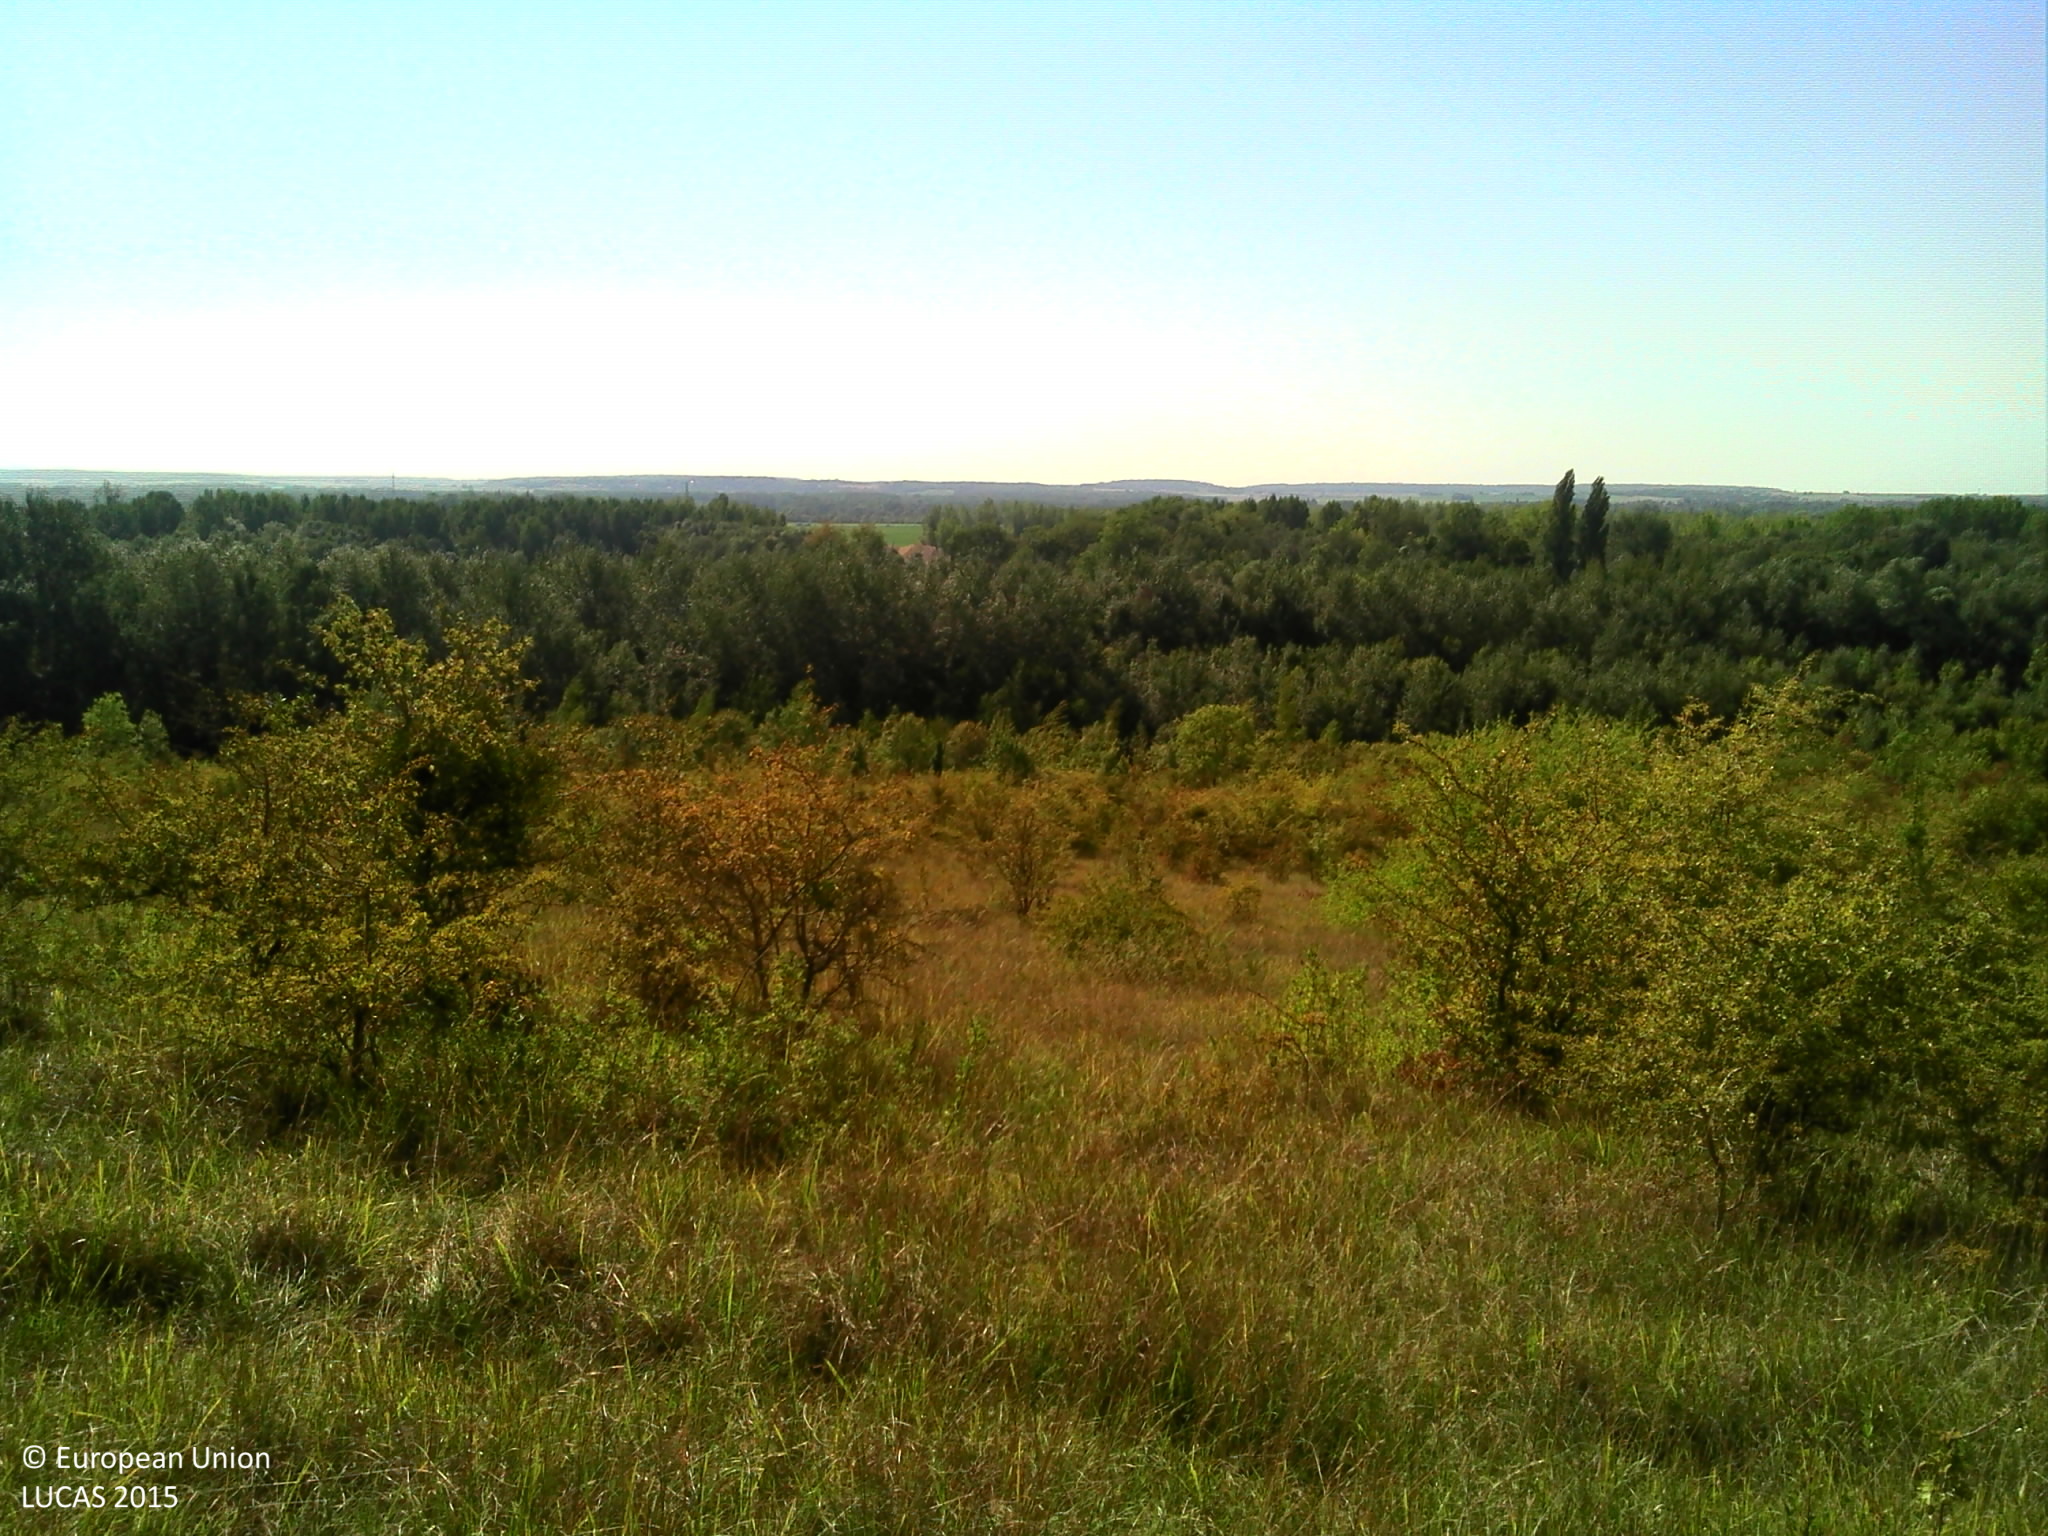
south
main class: Shrubland
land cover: Shrubland with sparse tree cover
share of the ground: > 75 %
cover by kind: herbaceous plants 85 %, shrubs 10 %, broadleaved forest trees 5 %
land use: Semi-natural and natural areas not in use
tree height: < 5 m
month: September
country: FR
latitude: 48.3988
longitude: 3.0090
